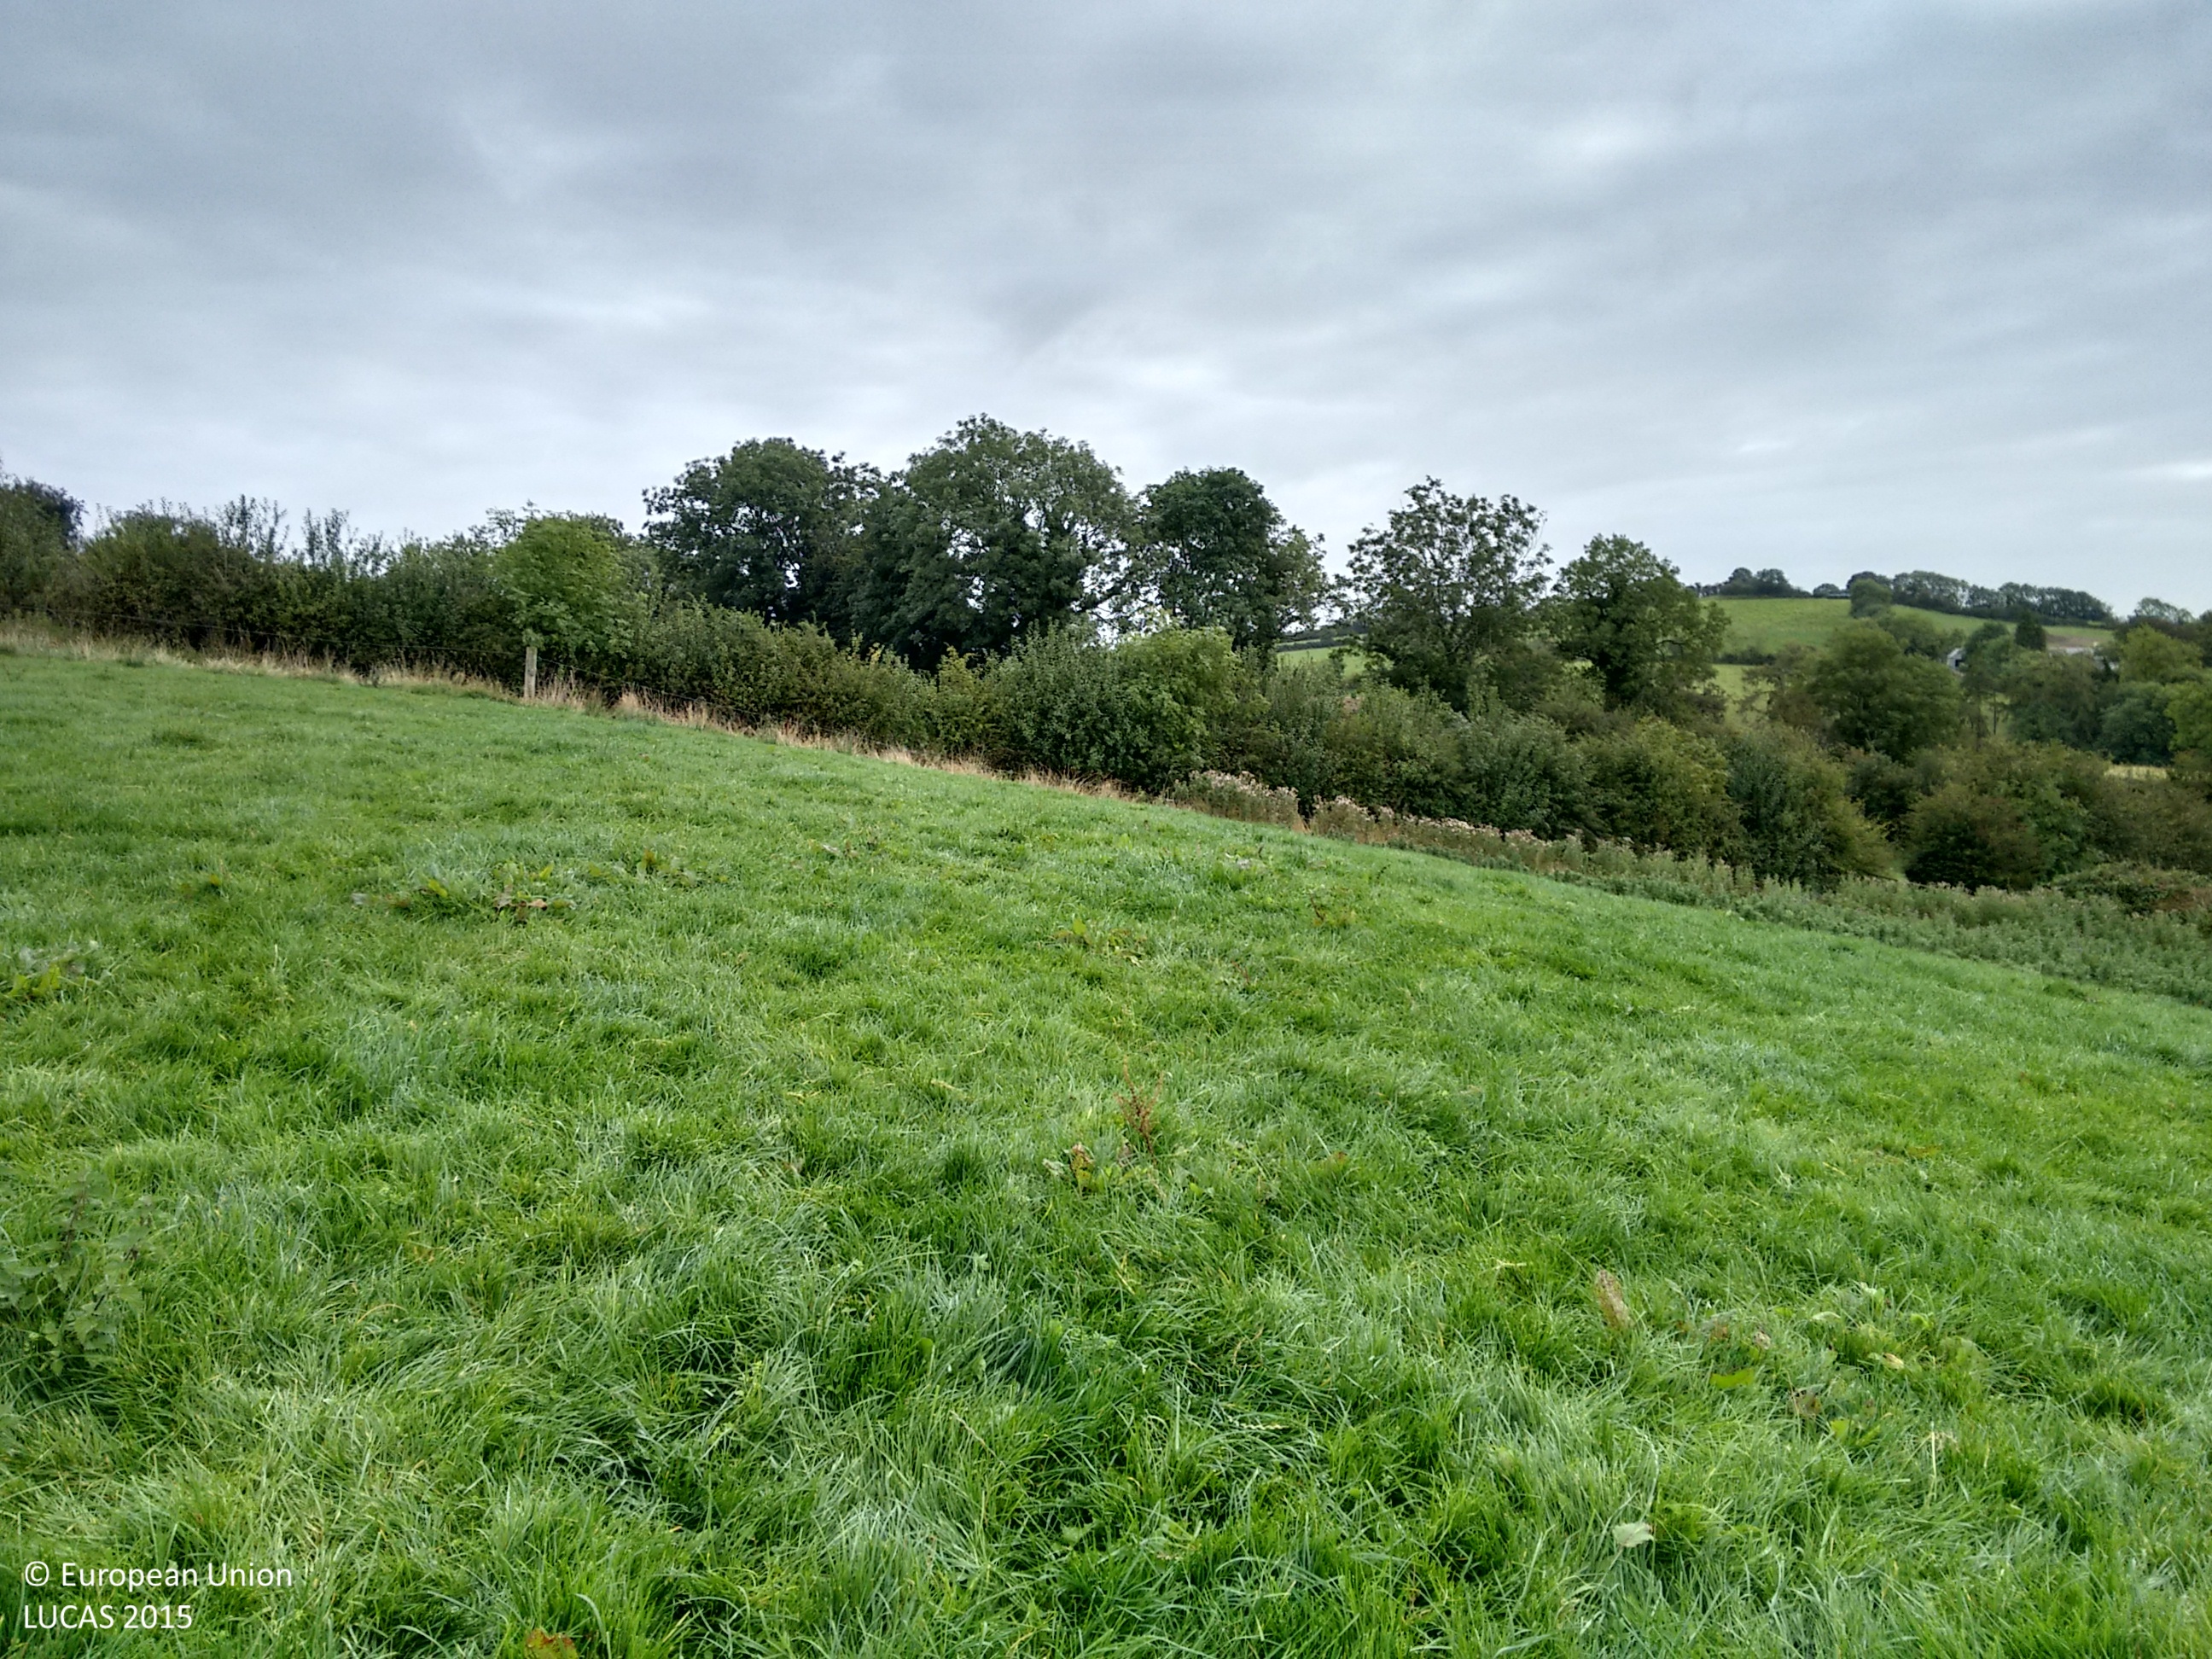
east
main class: Grassland
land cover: Grassland without tree/shrub cover
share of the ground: > 75 %
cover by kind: herbaceous plants 100 %
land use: Agriculture (excluding fallow land and kitchen gardens)
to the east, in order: Grassland without tree/shrub cover; Fences; Grassland without tree/shrub cover; Managed hedges; Grassland without tree/shrub cover; Fences; Managed hedges; Grassland without tree/shrub cover; Ditches and canals; Grassland without tree/shrub cover
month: September
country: IE
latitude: 54.1688
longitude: -6.9106
